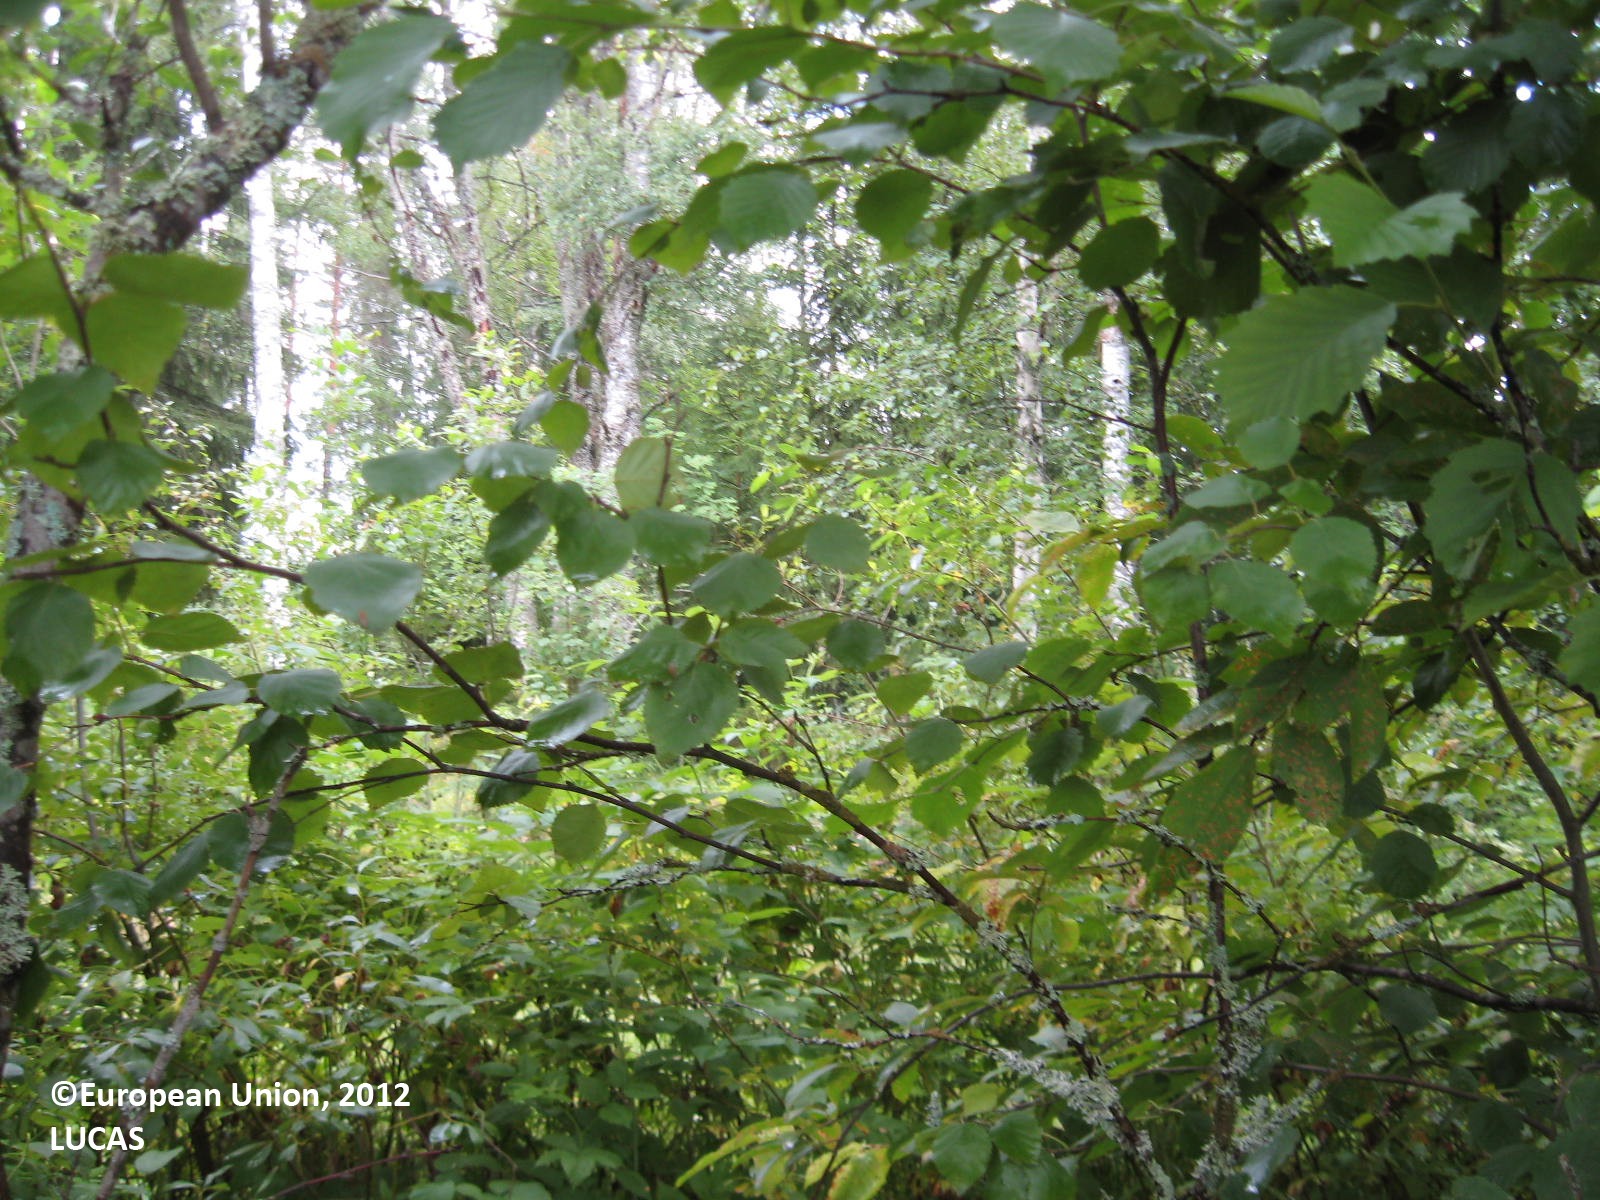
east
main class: Woodland
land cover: Broadleaved woodland
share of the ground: > 75 %
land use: Forestry
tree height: > 5 m
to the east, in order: Broadleaved woodland; Ditches and canals; Shruby margins; Tracks; Other mixed woodland; Electric lines; Other mixed woodland; Other coniferous woodland; Ditches and canals; Grass margins; Paved roads, cycling and walking lanes; Grass margins; Ditches and canals; Grass margins; Paved roads, cycling and walking lanes; Grass margins; Grassland without tree/shrub cover; Ditches and canals; Grass margins; Oats; Grass margins; Ditches and canals; Grassland without tree/shrub cover; Other coniferous woodland
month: July
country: FI
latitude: 62.0870
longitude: 22.5249
